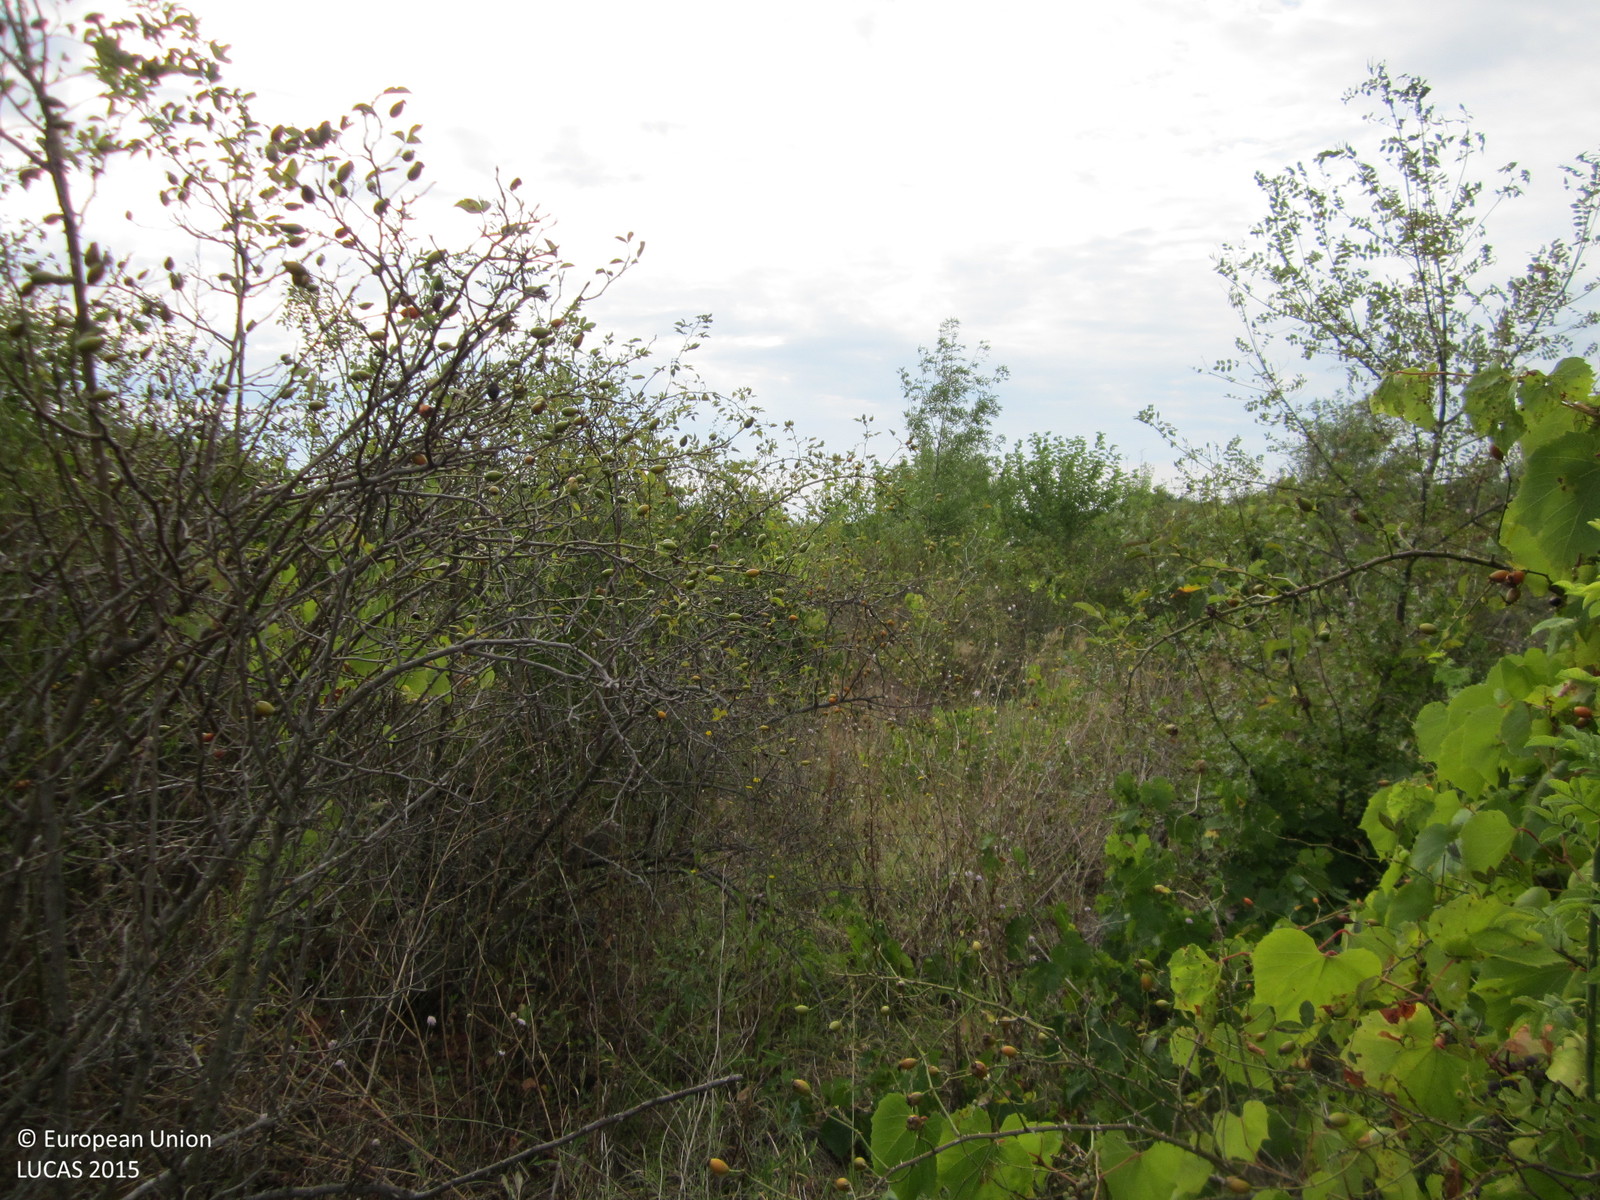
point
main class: Cropland
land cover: Vineyards
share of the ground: 25 - 50 %
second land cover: Shrubland without tree cover
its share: 25 - 50 %
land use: Abandoned areas
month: August
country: BG
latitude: 42.6146
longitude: 27.3658
